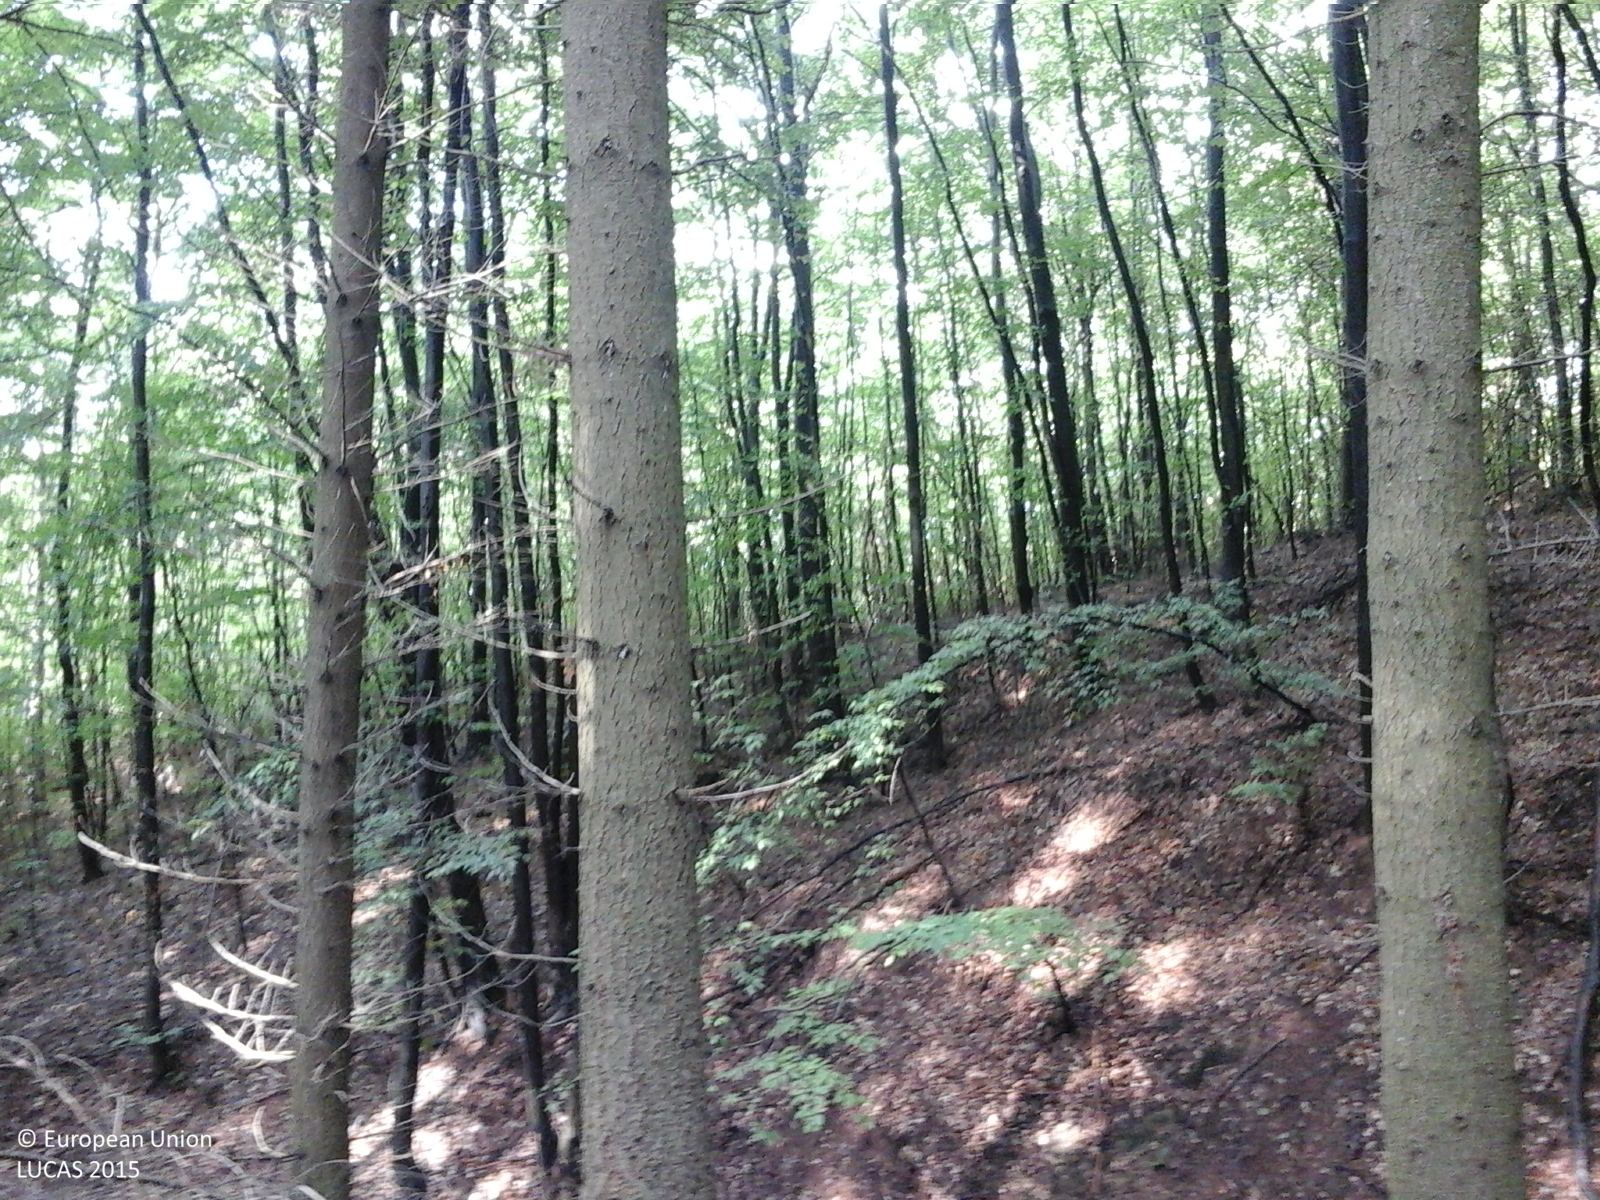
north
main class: Woodland
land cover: Pine dominated mixed woodland
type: alpine coniferous forest
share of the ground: > 75 %
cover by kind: coniferous forest trees 75 %, broadleaved forest trees 25 %
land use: Forestry
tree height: > 5 m
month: September
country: RO
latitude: 46.9443
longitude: 22.6552
